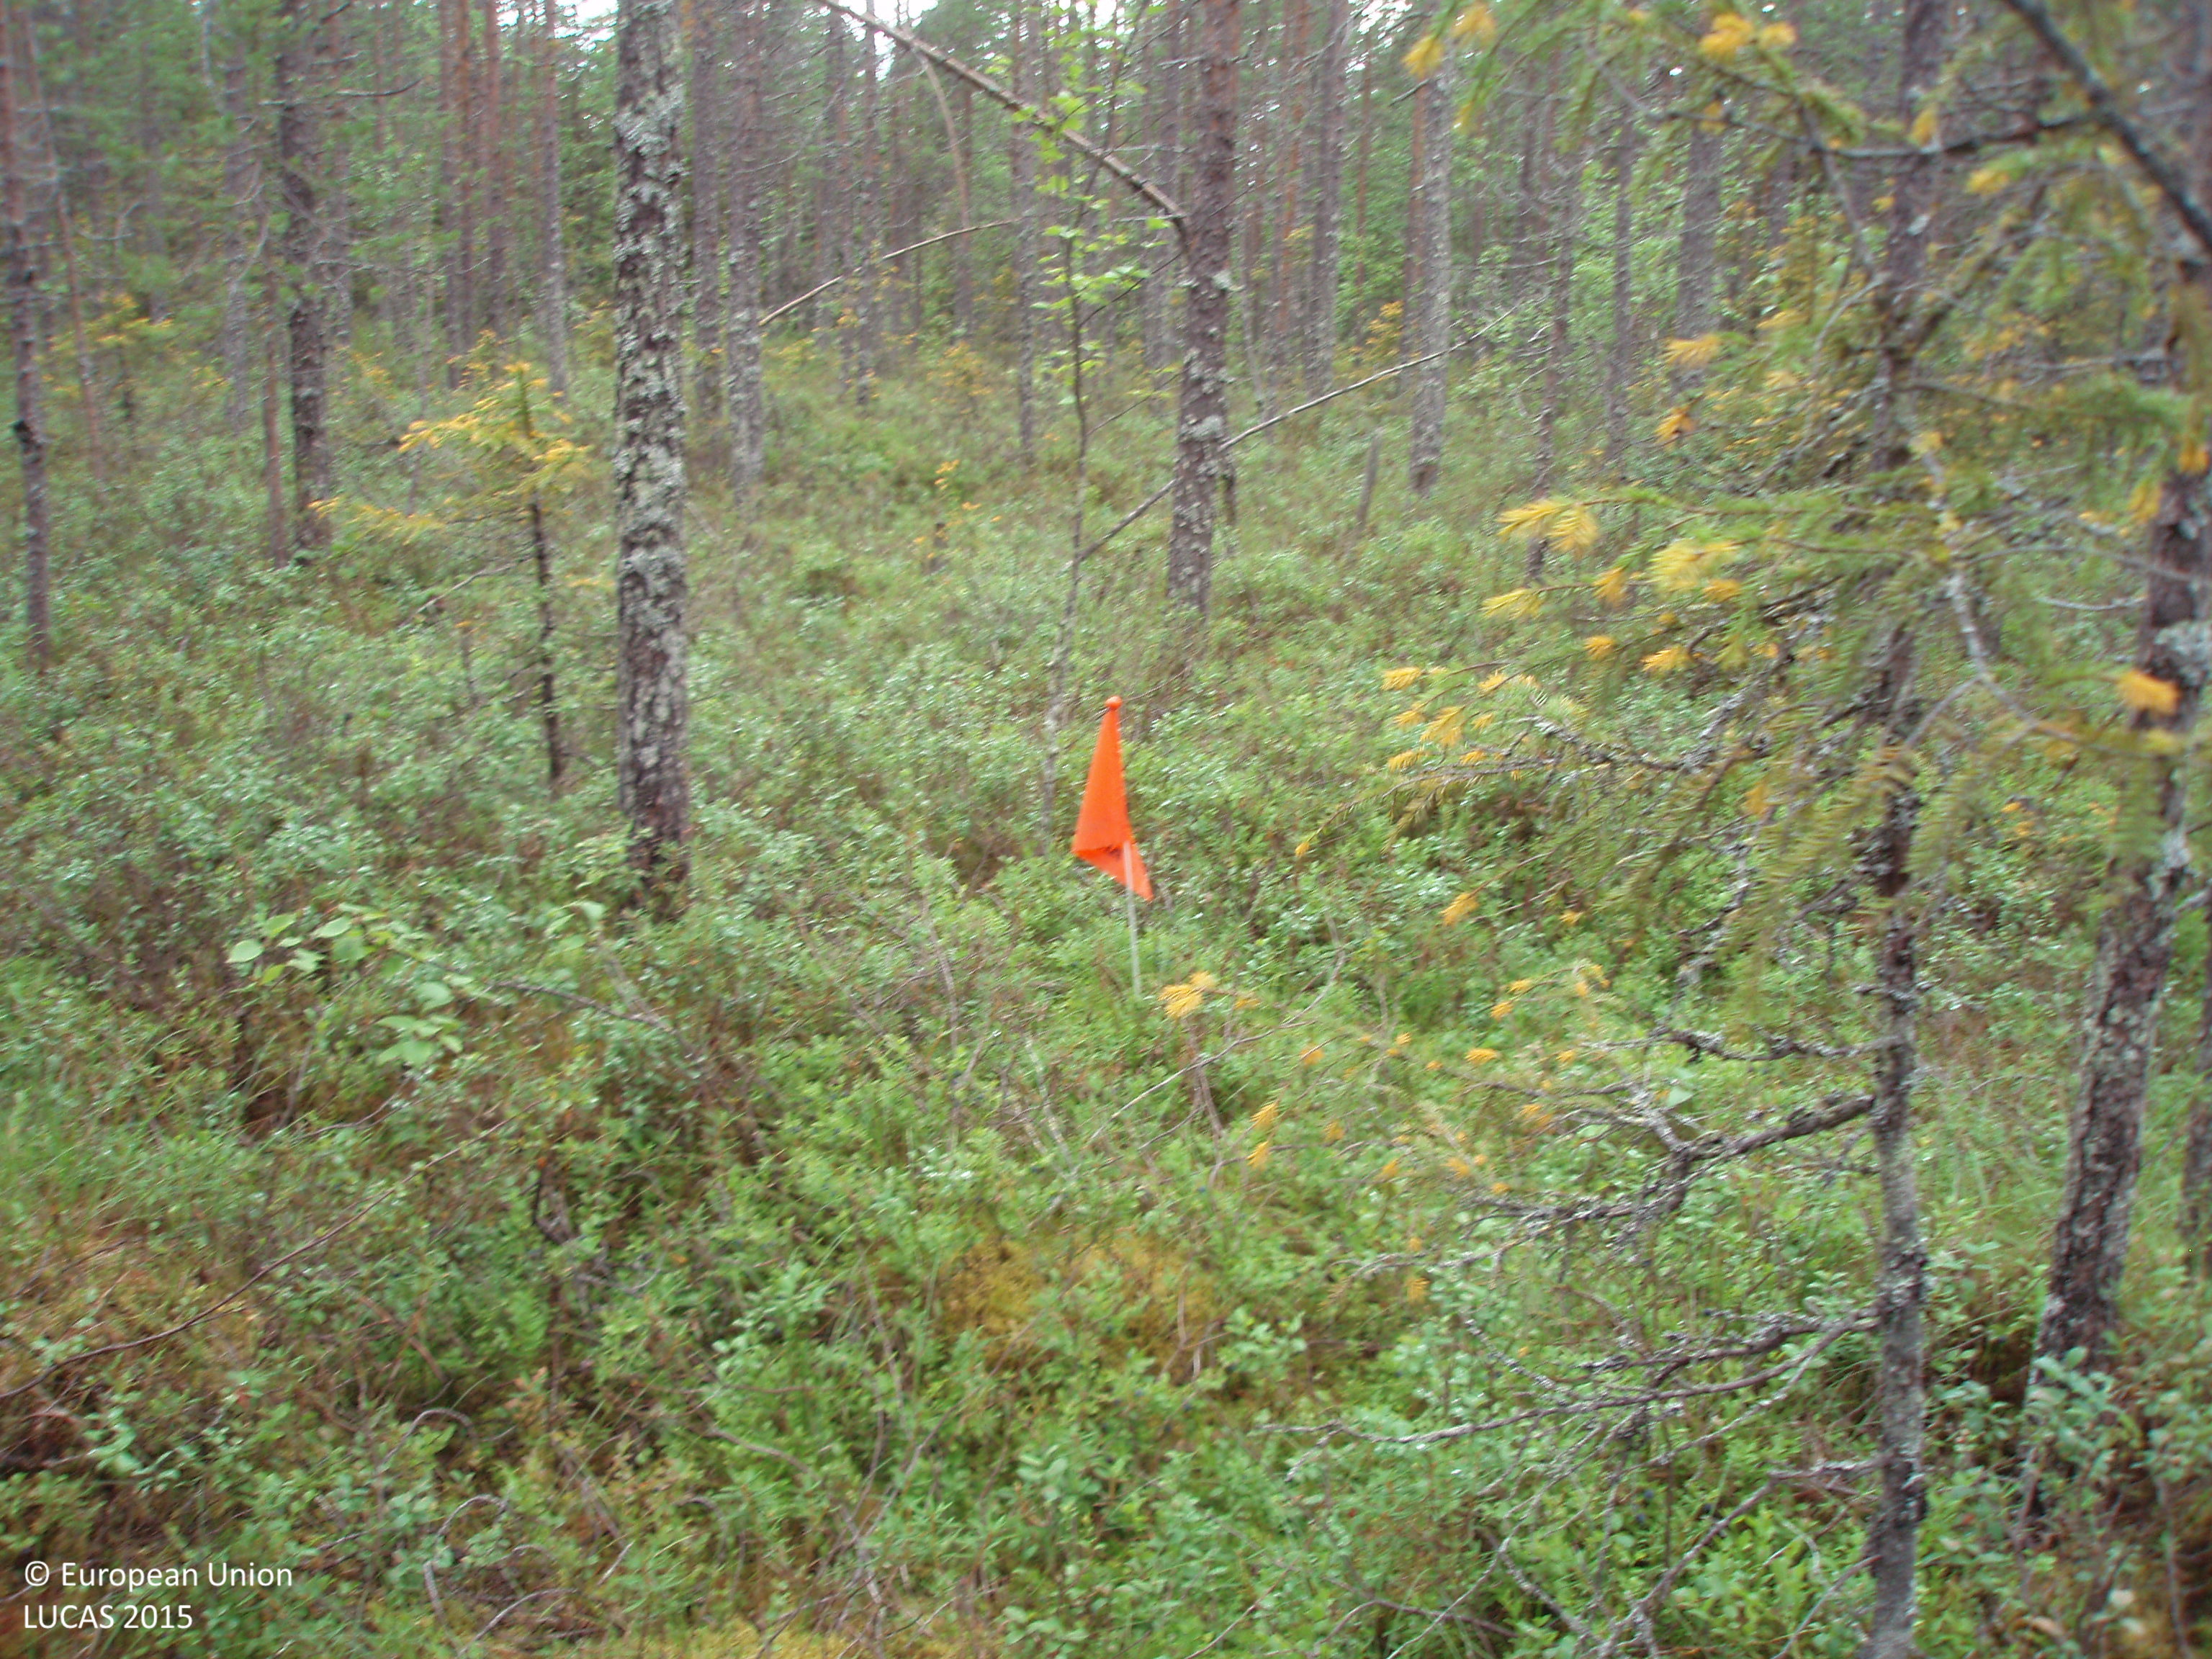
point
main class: Woodland
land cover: Pine dominated coniferous woodland
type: boreal forest
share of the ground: 50 - 75 %
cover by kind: coniferous forest trees 70 %, shrubs 25 %, lichens and mosses 5 %
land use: Forestry
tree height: > 5 m
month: August
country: FI
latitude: 65.5799
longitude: 27.2682
